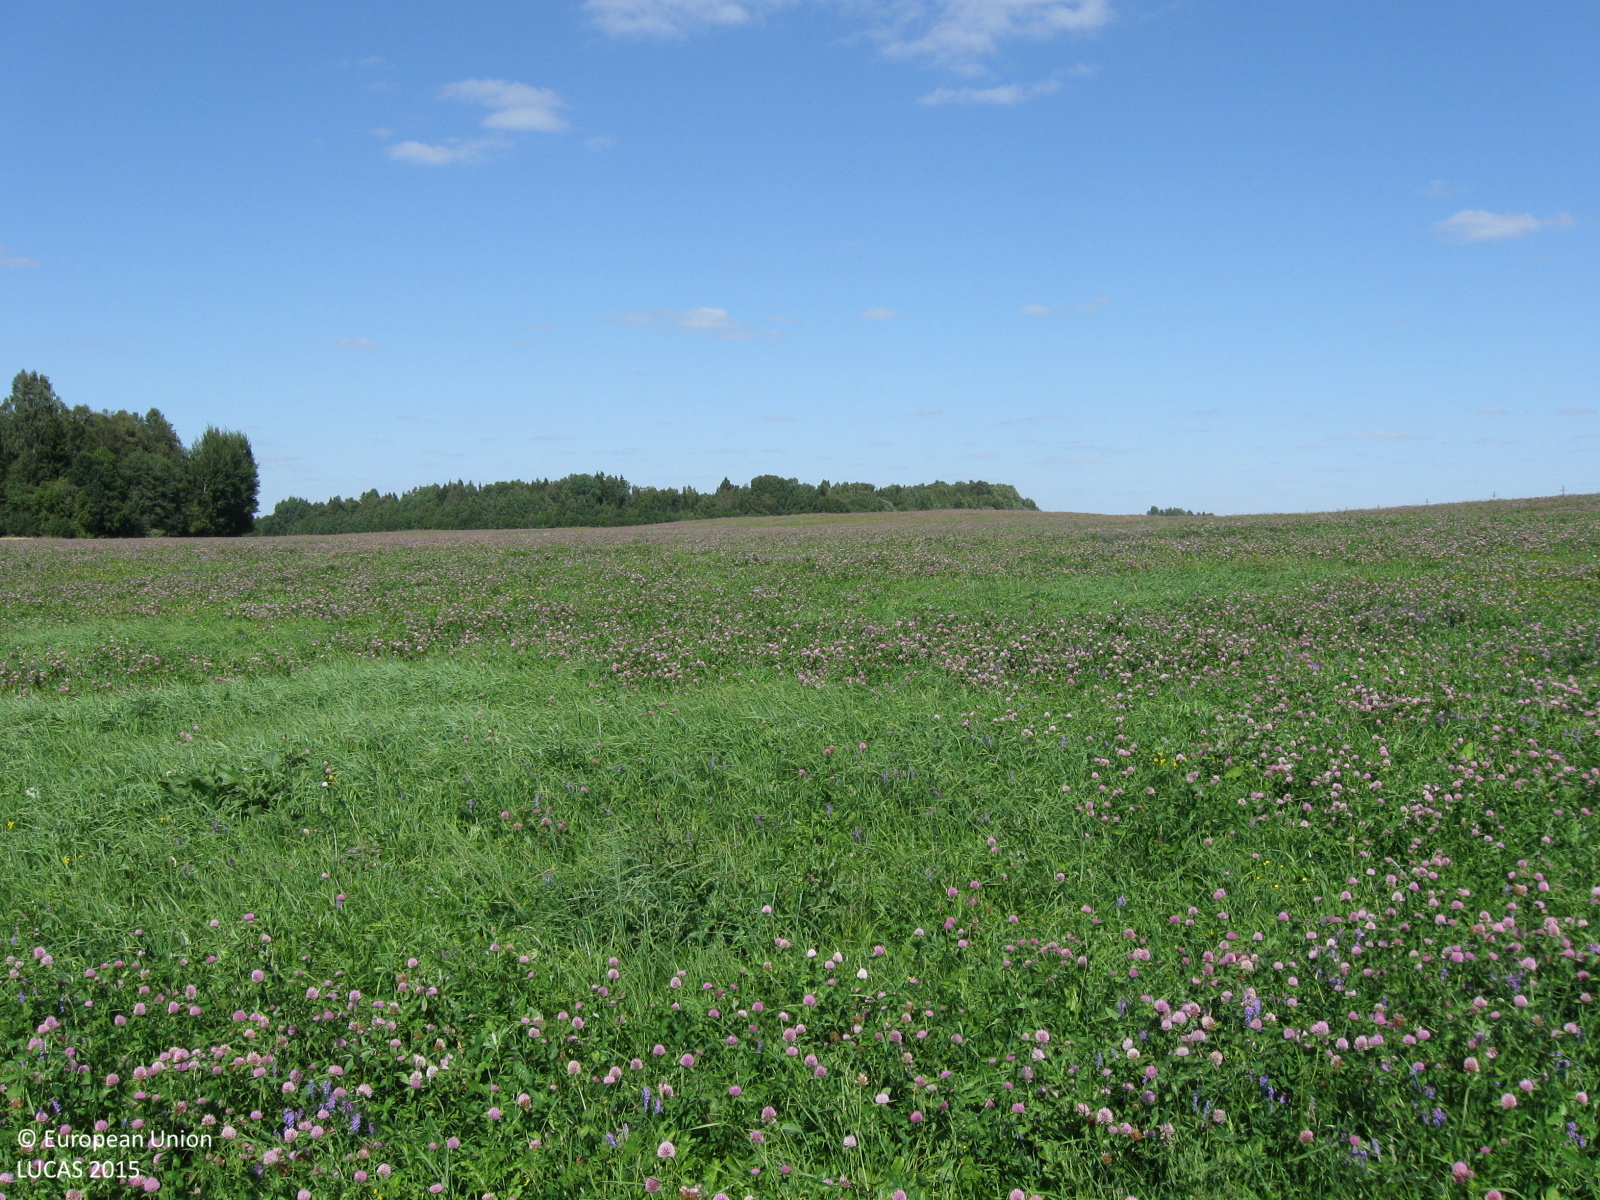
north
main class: Cropland
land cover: Other leguminous and mixtures for fodder
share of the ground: > 75 %
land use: Agriculture (excluding fallow land and kitchen gardens)
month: August
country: LT
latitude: 55.5454
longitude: 22.5990
